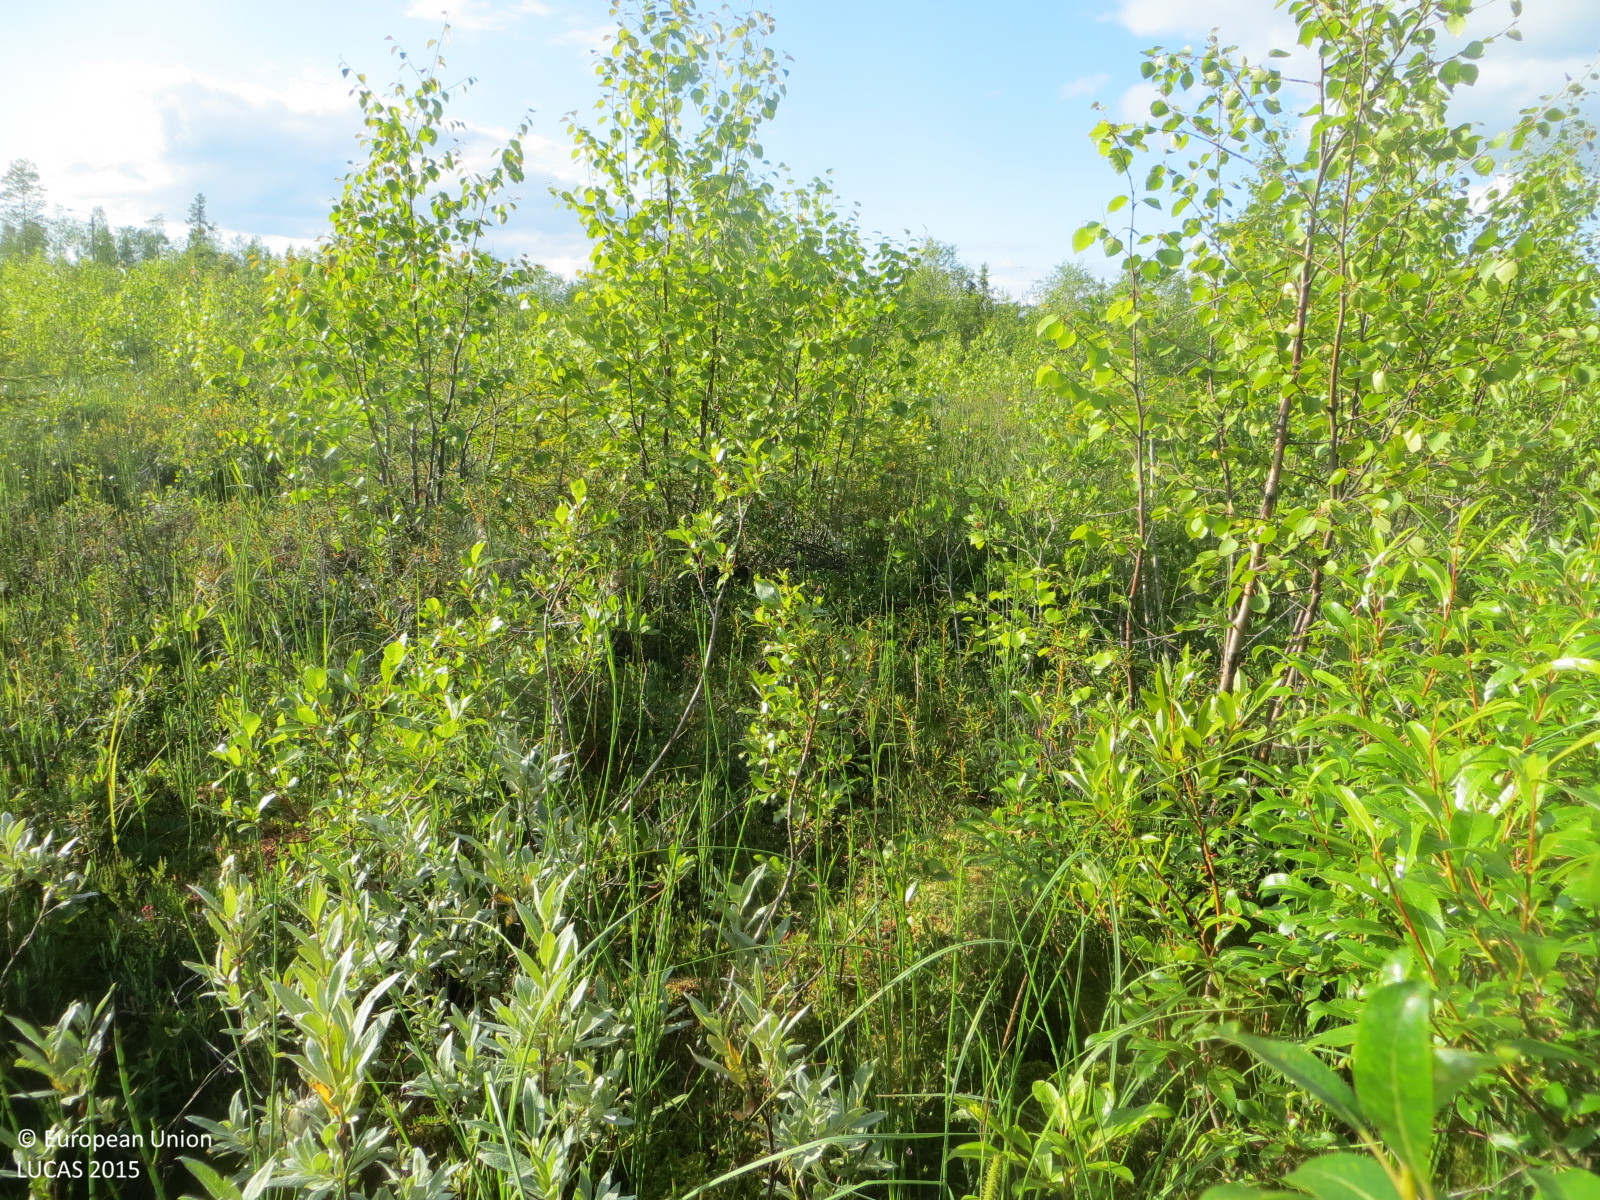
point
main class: Shrubland
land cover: Shrubland with sparse tree cover
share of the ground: > 75 %
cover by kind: shrubs 55 %, lichens and mosses 40 %, broadleaved forest trees 5 %
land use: Electricity, gas and thermal power distribution
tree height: < 5 m
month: July
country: FI
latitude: 65.9610
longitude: 24.0579
